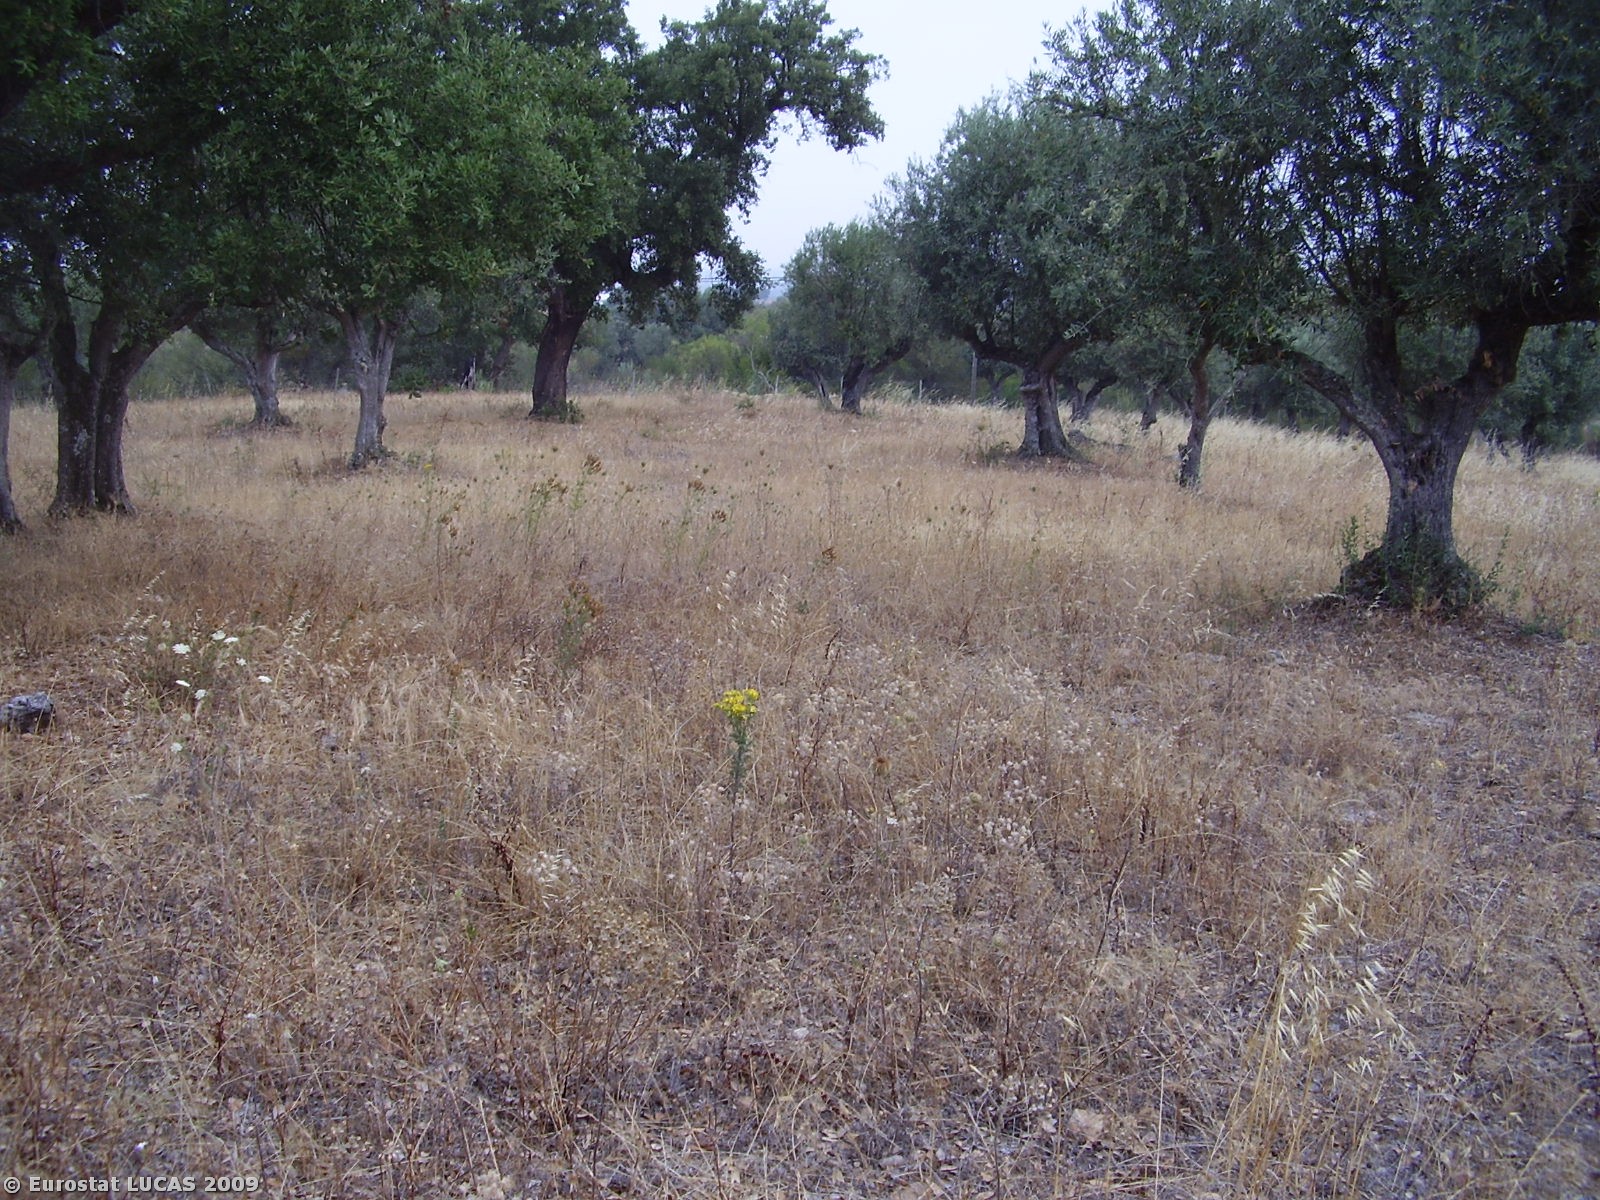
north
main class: Cropland
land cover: Olive groves
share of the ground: 10 - 25 %
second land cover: Spontaneously vegetated surfaces
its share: 50 - 75 %
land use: Agriculture (excluding fallow land and kitchen gardens)
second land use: Fallow land
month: July
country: PT
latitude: 38.8168
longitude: -7.8598
